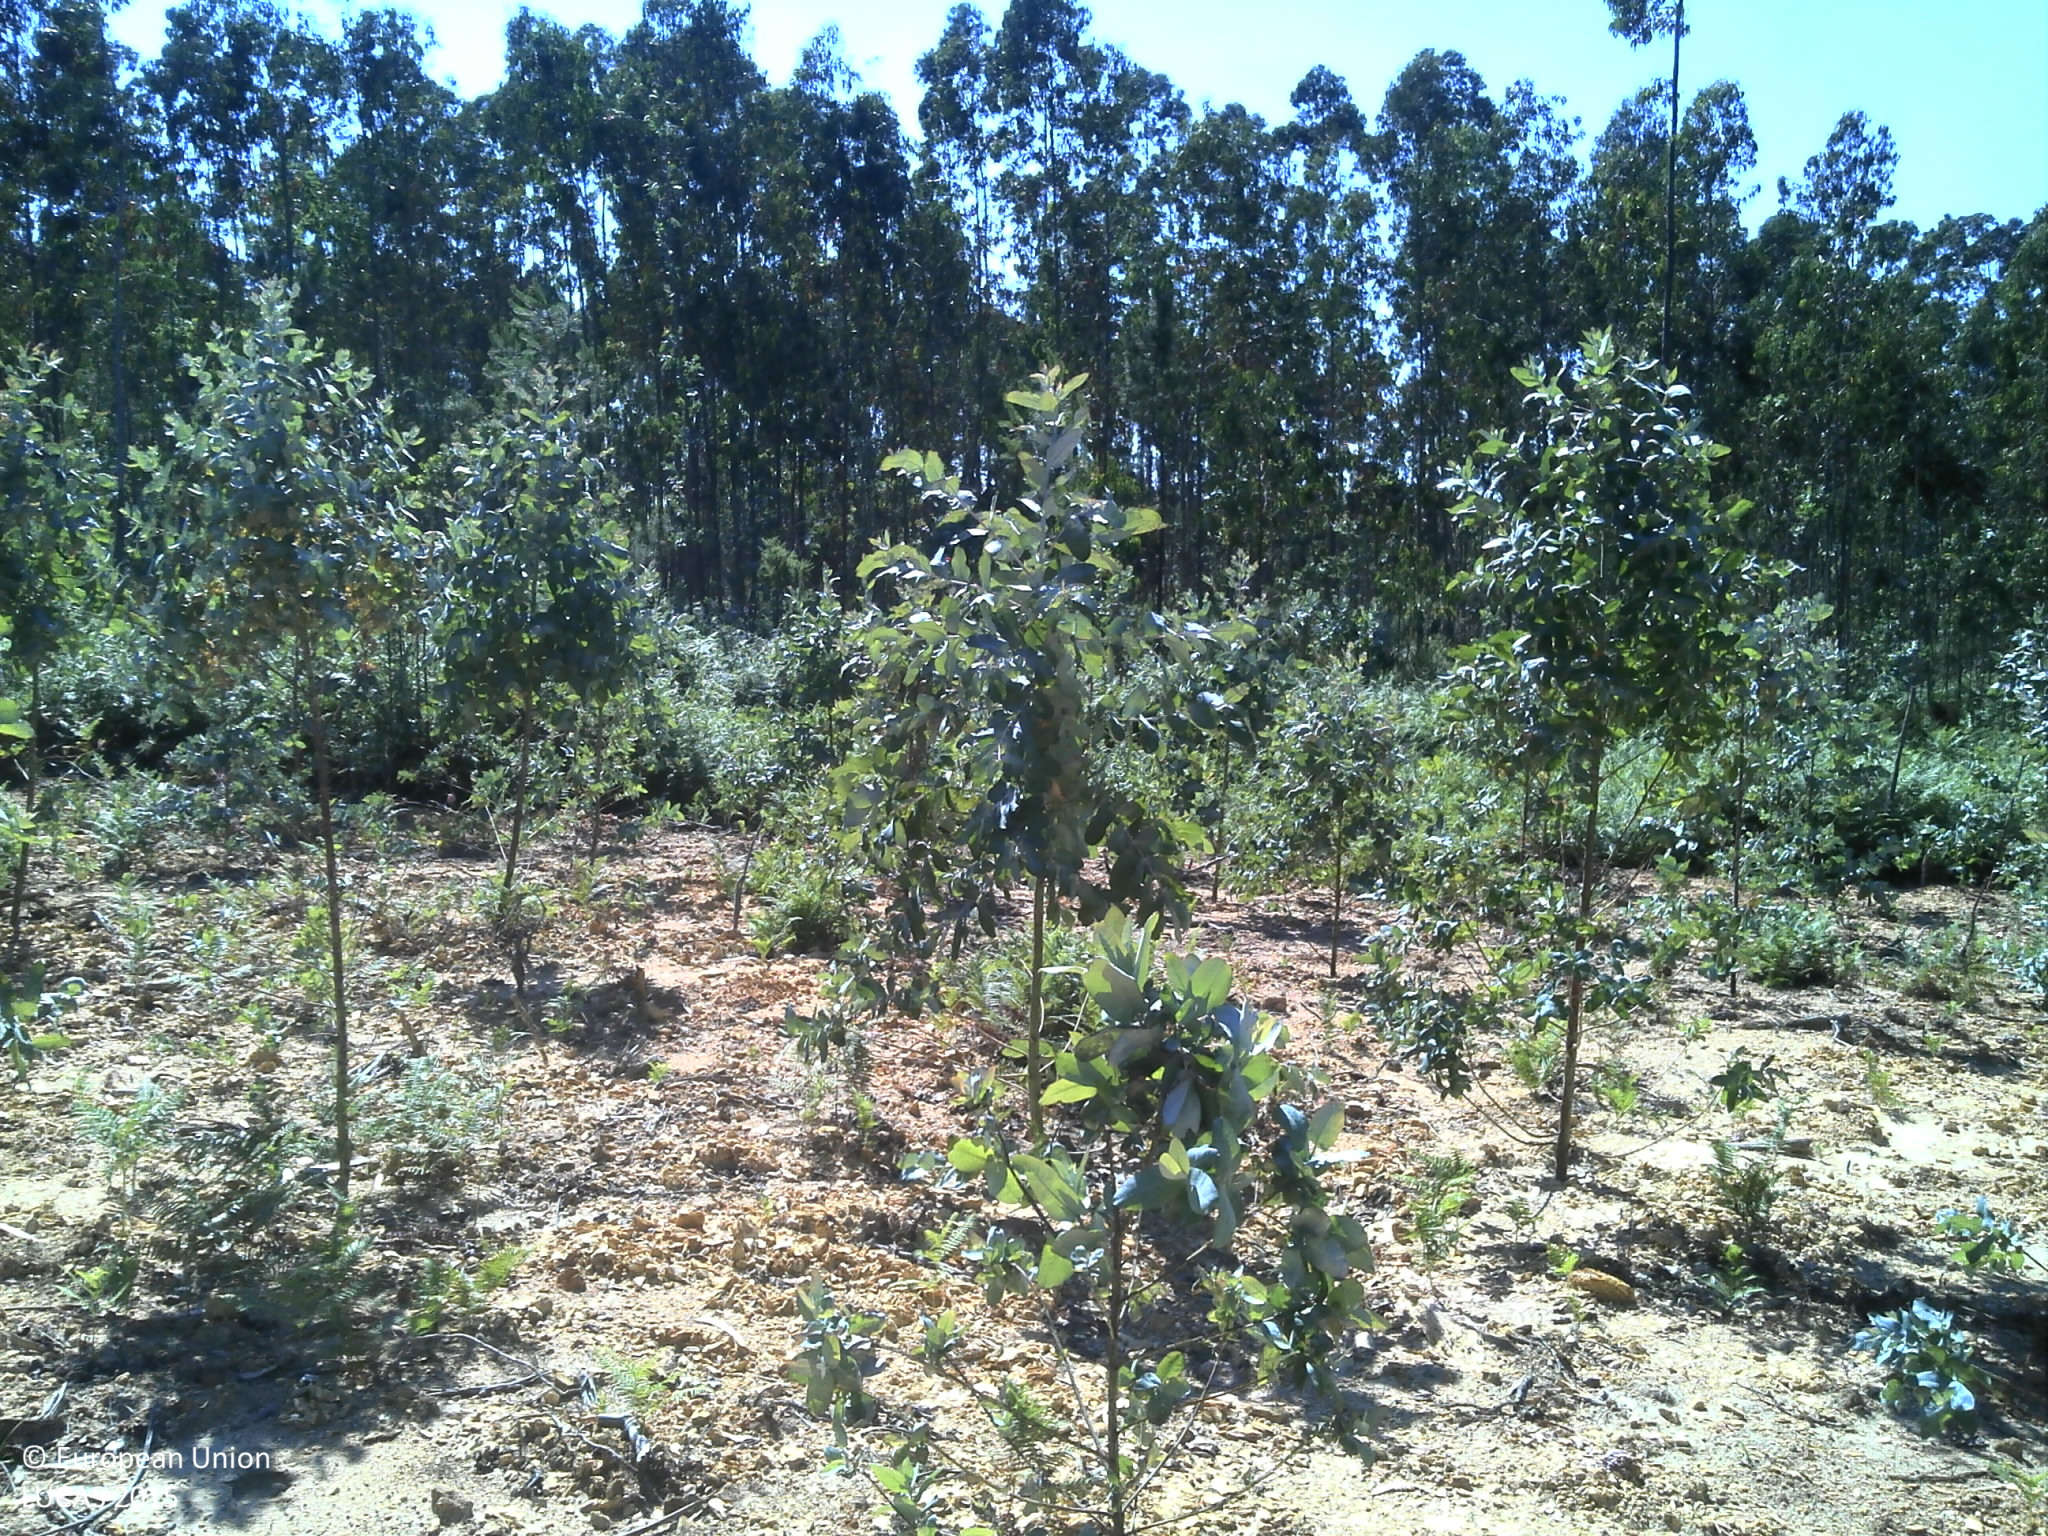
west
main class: Woodland
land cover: Broadleaved woodland
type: exotic forest
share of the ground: 25 - 50 %
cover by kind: unconsolidated bare surface 65 %, broadleaved forest trees 30 %, herbaceous plants 5 %
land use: Forestry
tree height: < 5 m
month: June
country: PT
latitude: 40.7320
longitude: -8.4827
